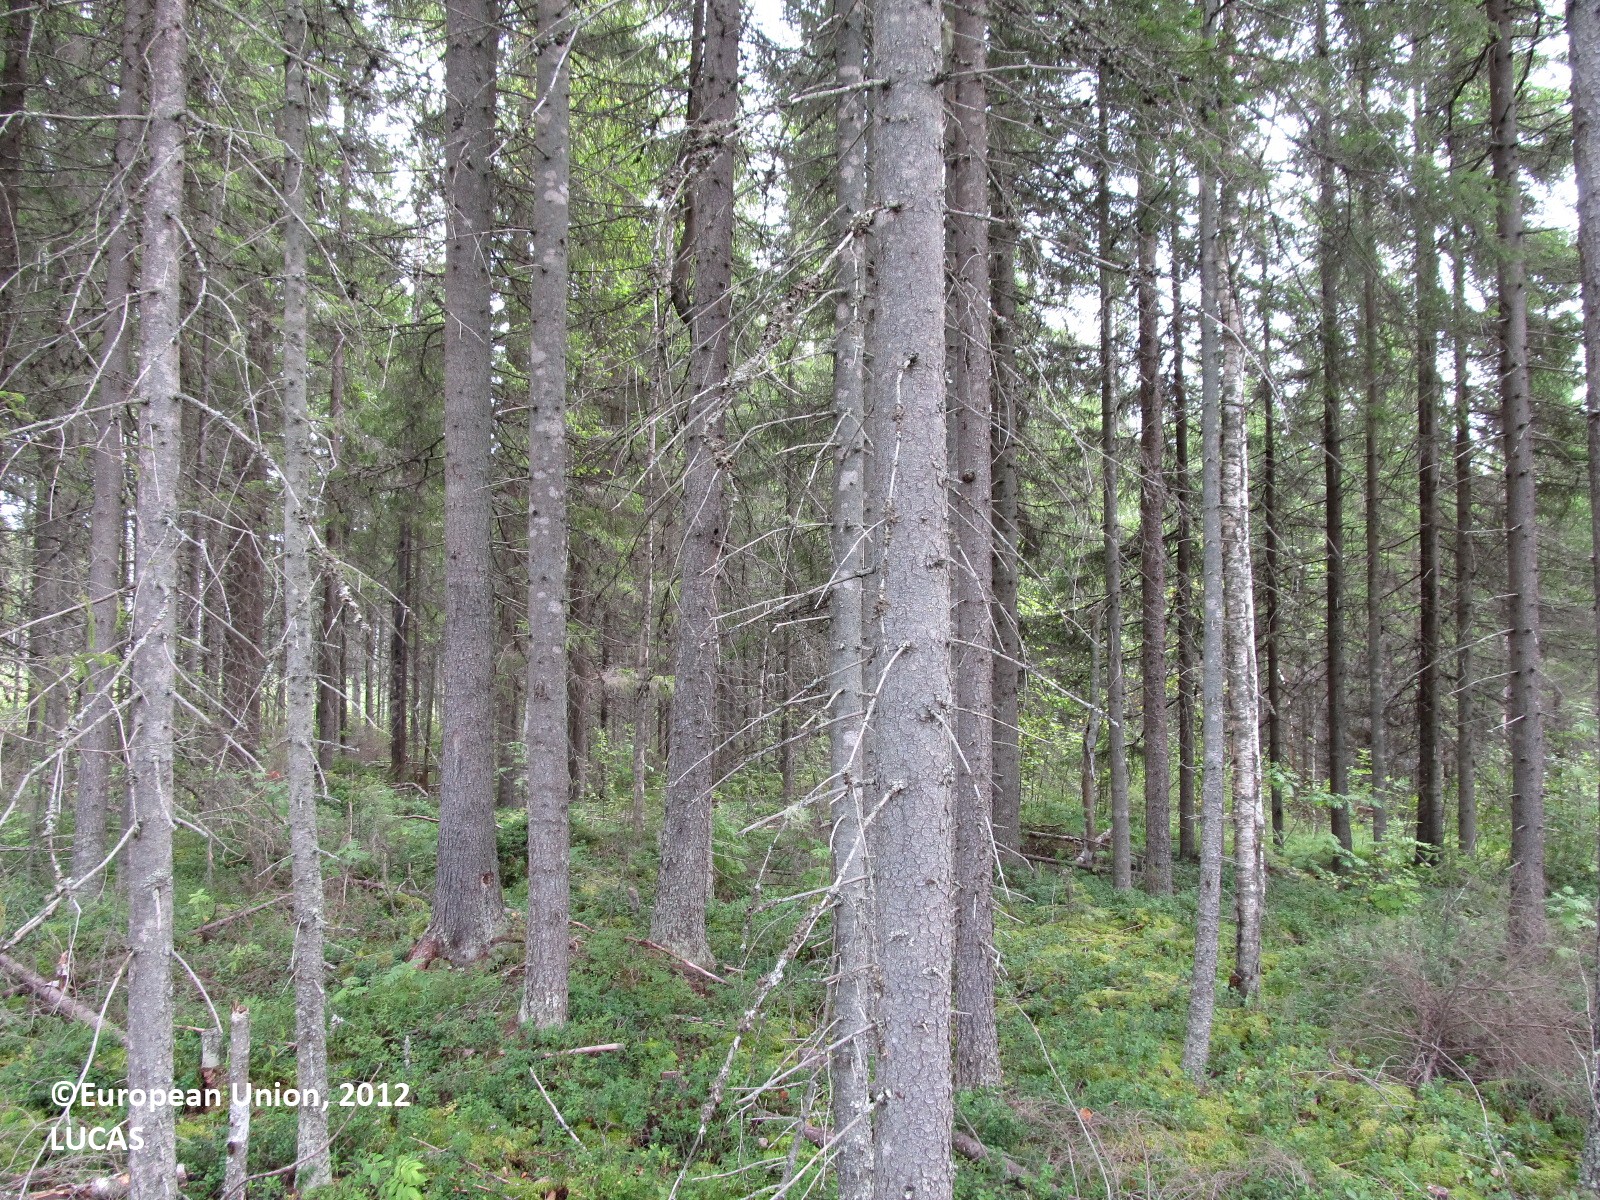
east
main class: Woodland
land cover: Spruce dominated coniferous woodland
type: boreal forest
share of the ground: 25 - 50 %
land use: Forestry
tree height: > 5 m
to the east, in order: Spruce dominated coniferous woodland; Ditches and canals; Spruce dominated mixed woodland
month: August
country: FI
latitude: 62.2954
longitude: 28.5809
